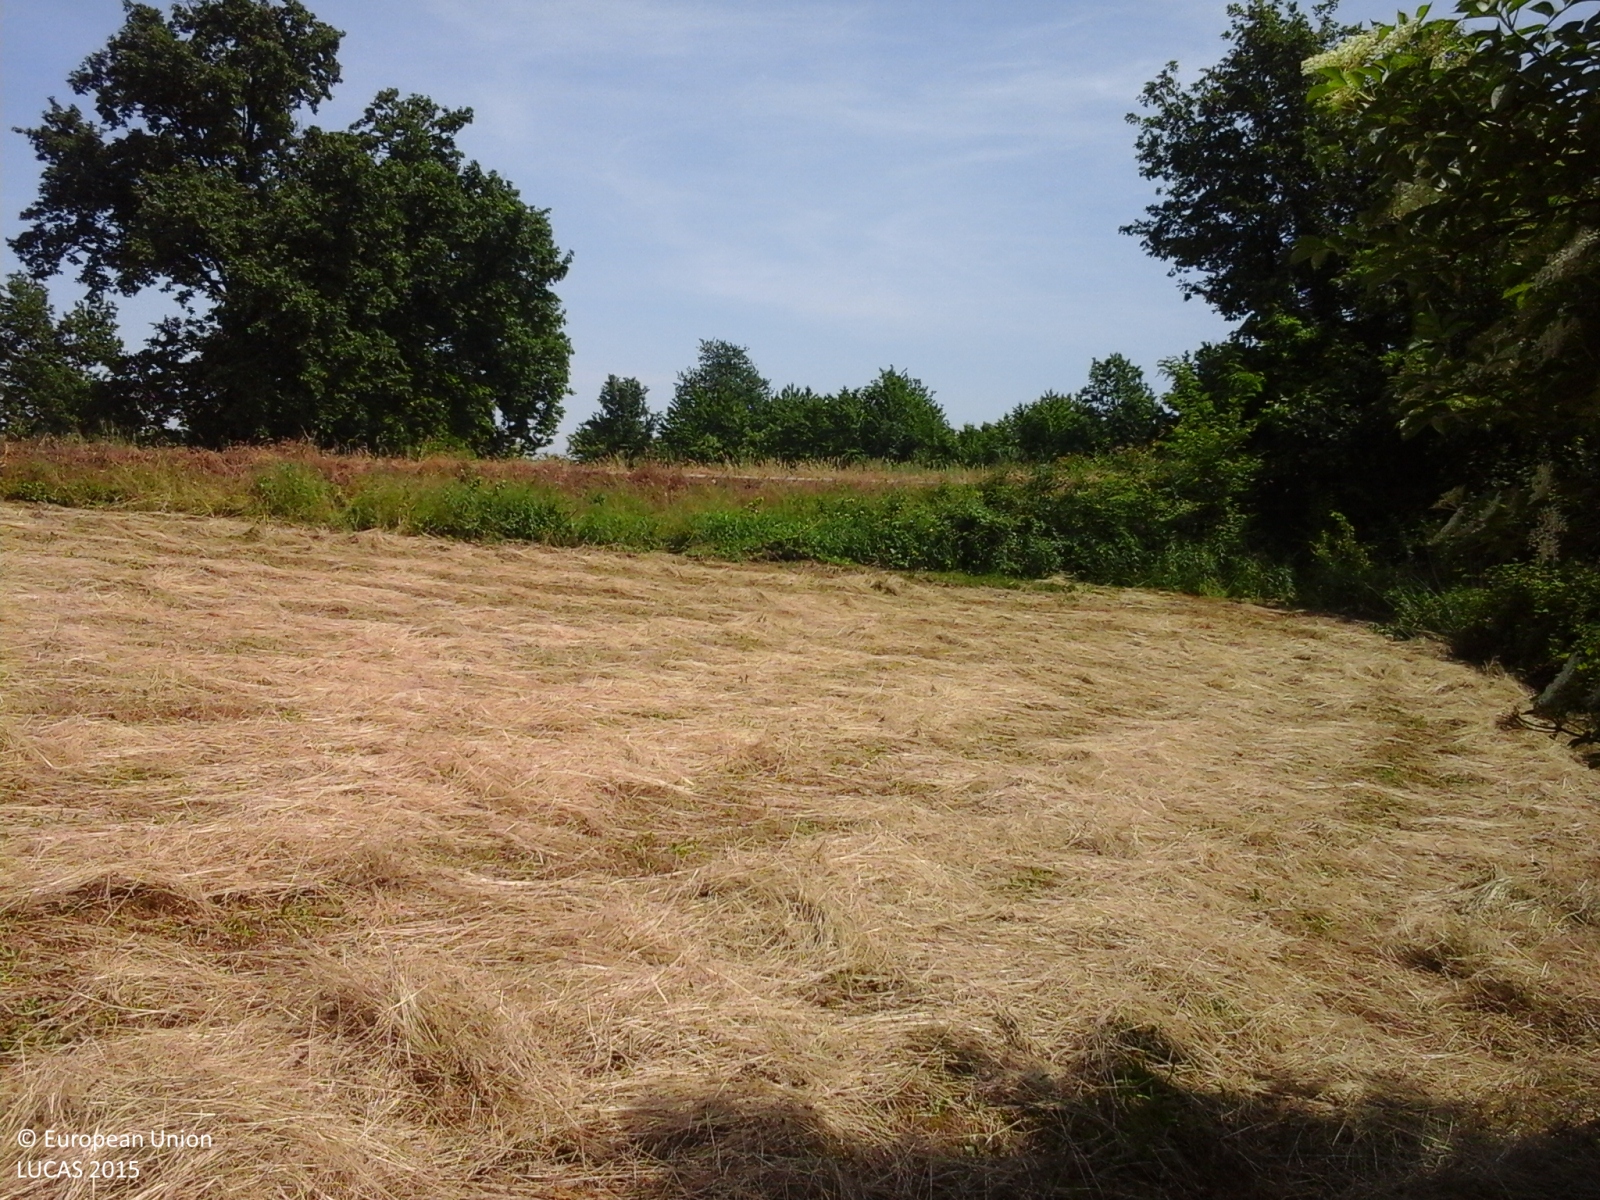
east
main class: Woodland
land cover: Broadleaved woodland
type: thermophilous deciduous forest
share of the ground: > 75 %
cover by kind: broadleaved forest trees 90 %, shrubs 10 %
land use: Forestry
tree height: < 5 m
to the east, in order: Broadleaved woodland; Grassland without tree/shrub cover; Paved roads, cycling and walking lanes; Grassland without tree/shrub cover; Broadleaved woodland
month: May
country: IT
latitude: 44.8961
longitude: 8.3191
